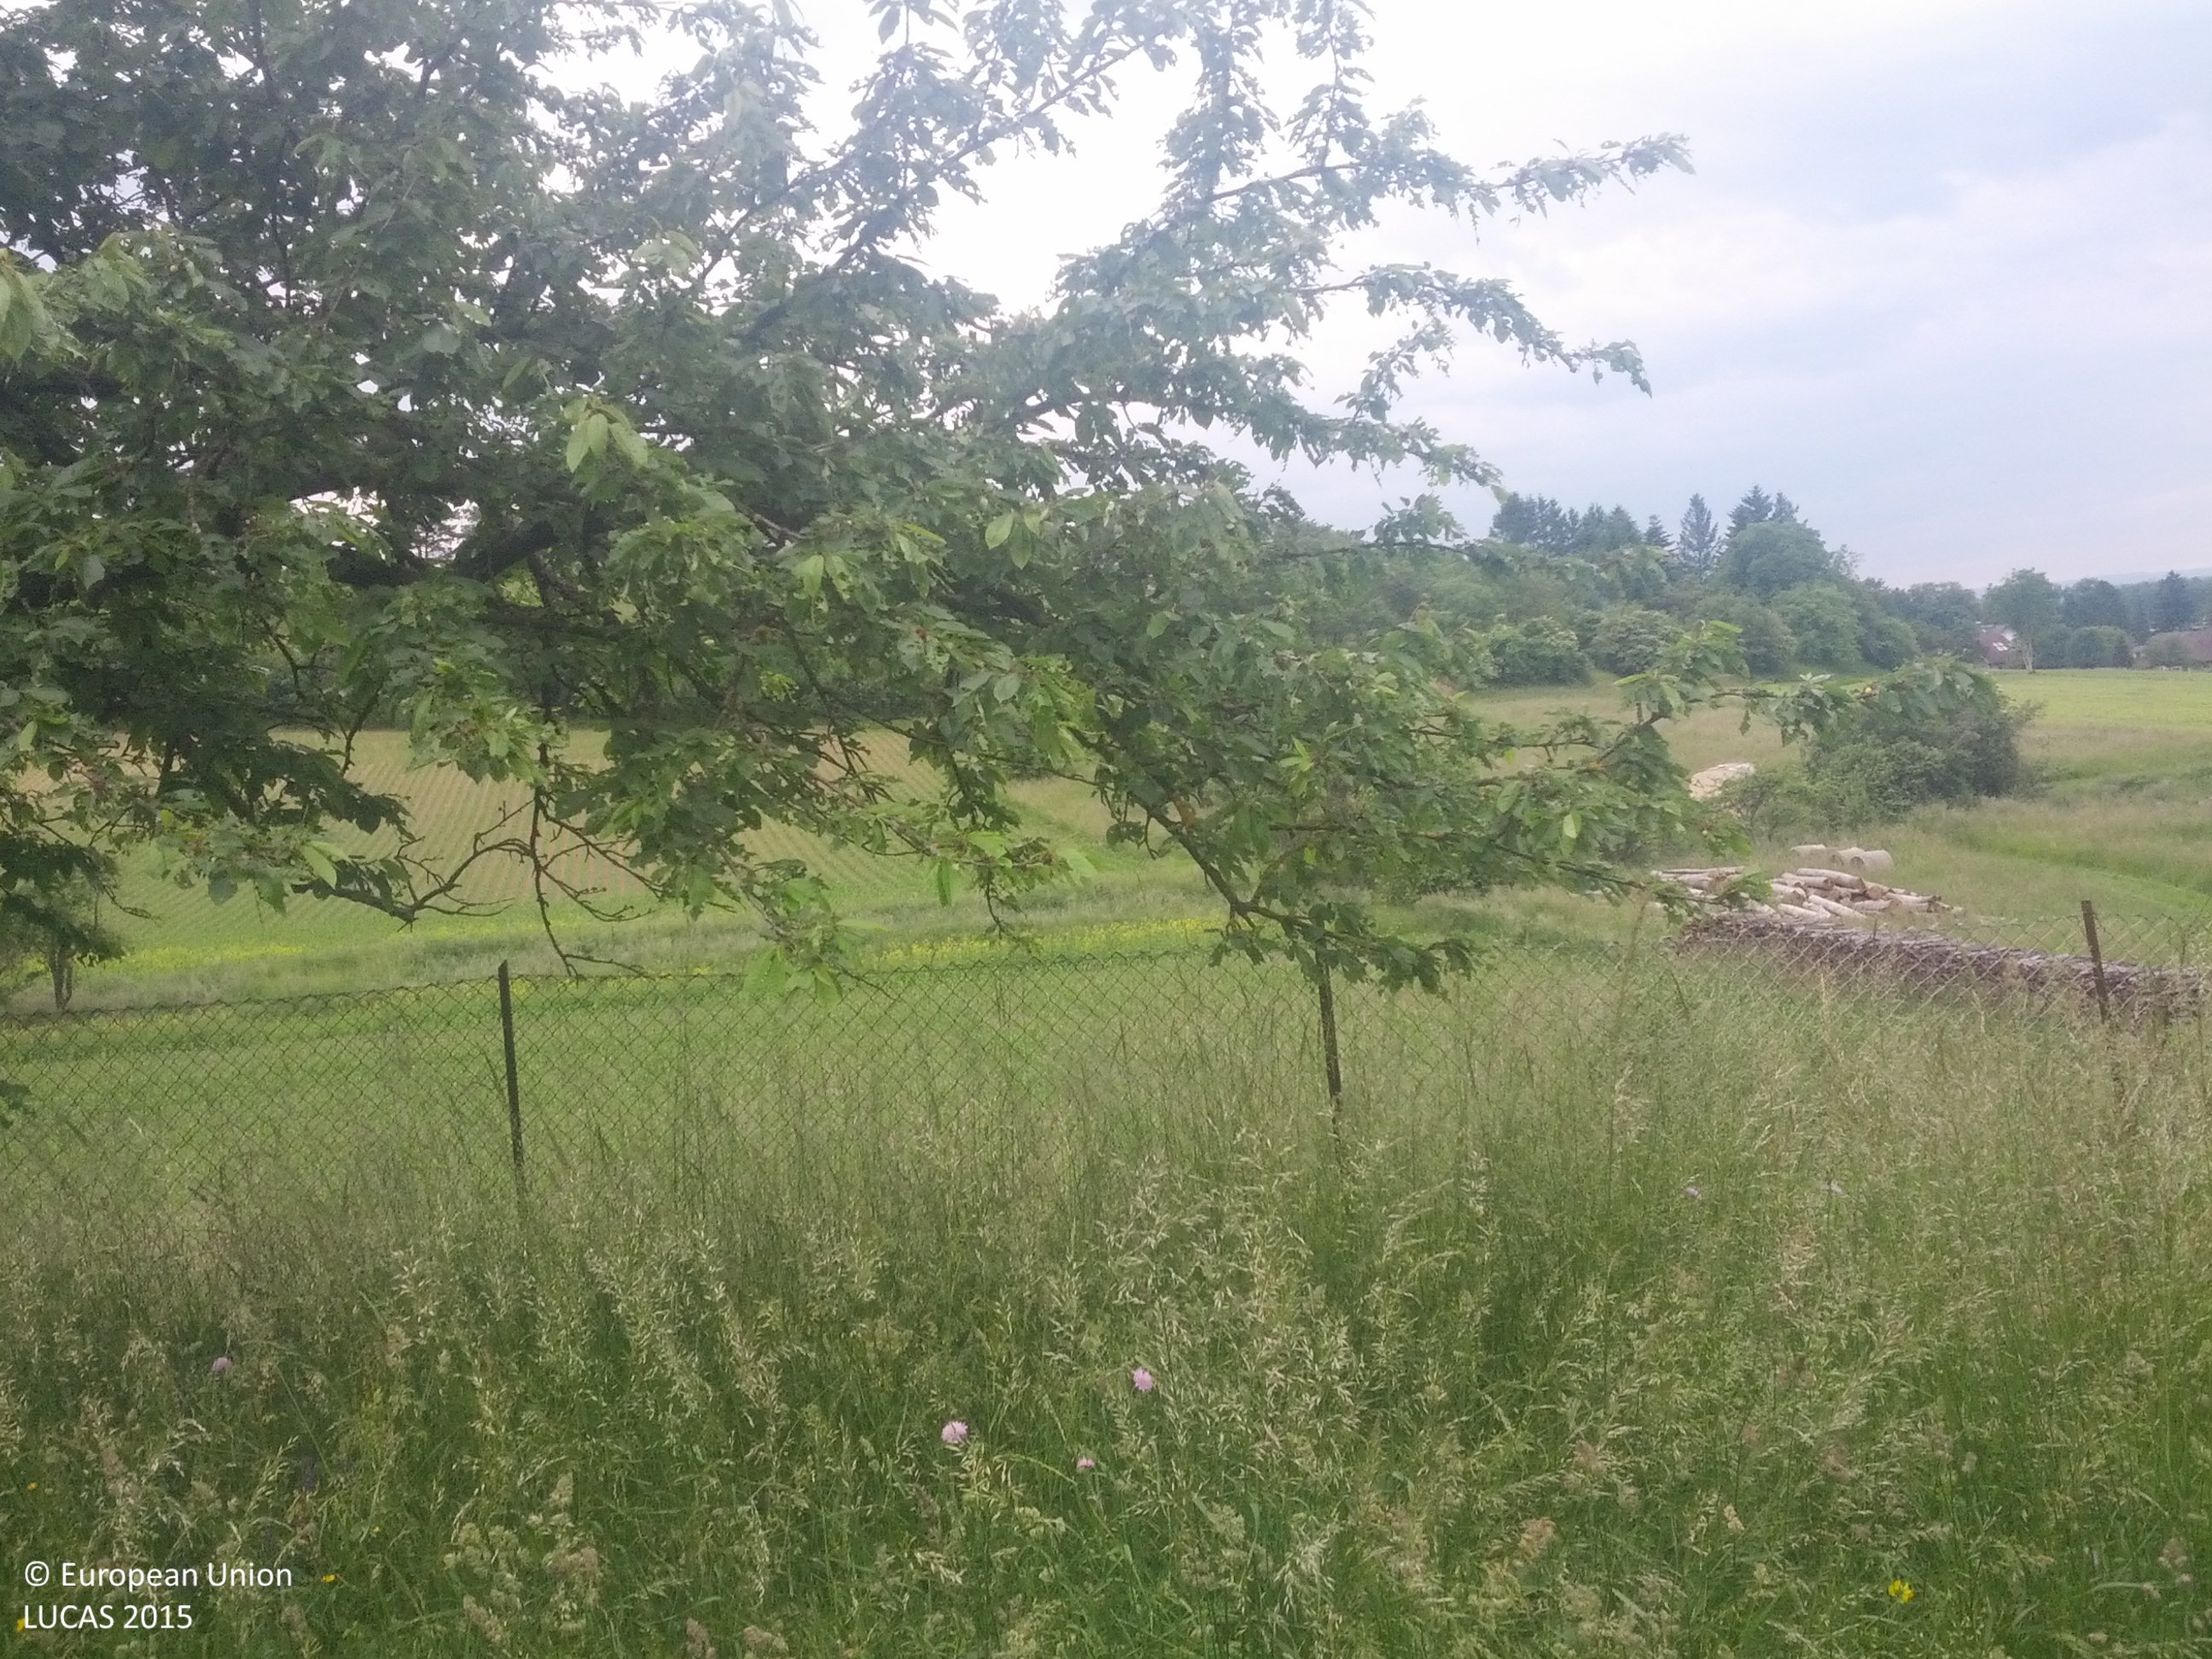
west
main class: Cropland
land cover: Cherry fruit
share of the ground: < 10 %
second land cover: Grassland without tree/shrub cover
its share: > 75 %
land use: Agriculture (excluding fallow land and kitchen gardens)
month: May
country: AT
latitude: 48.3036
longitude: 16.1656
